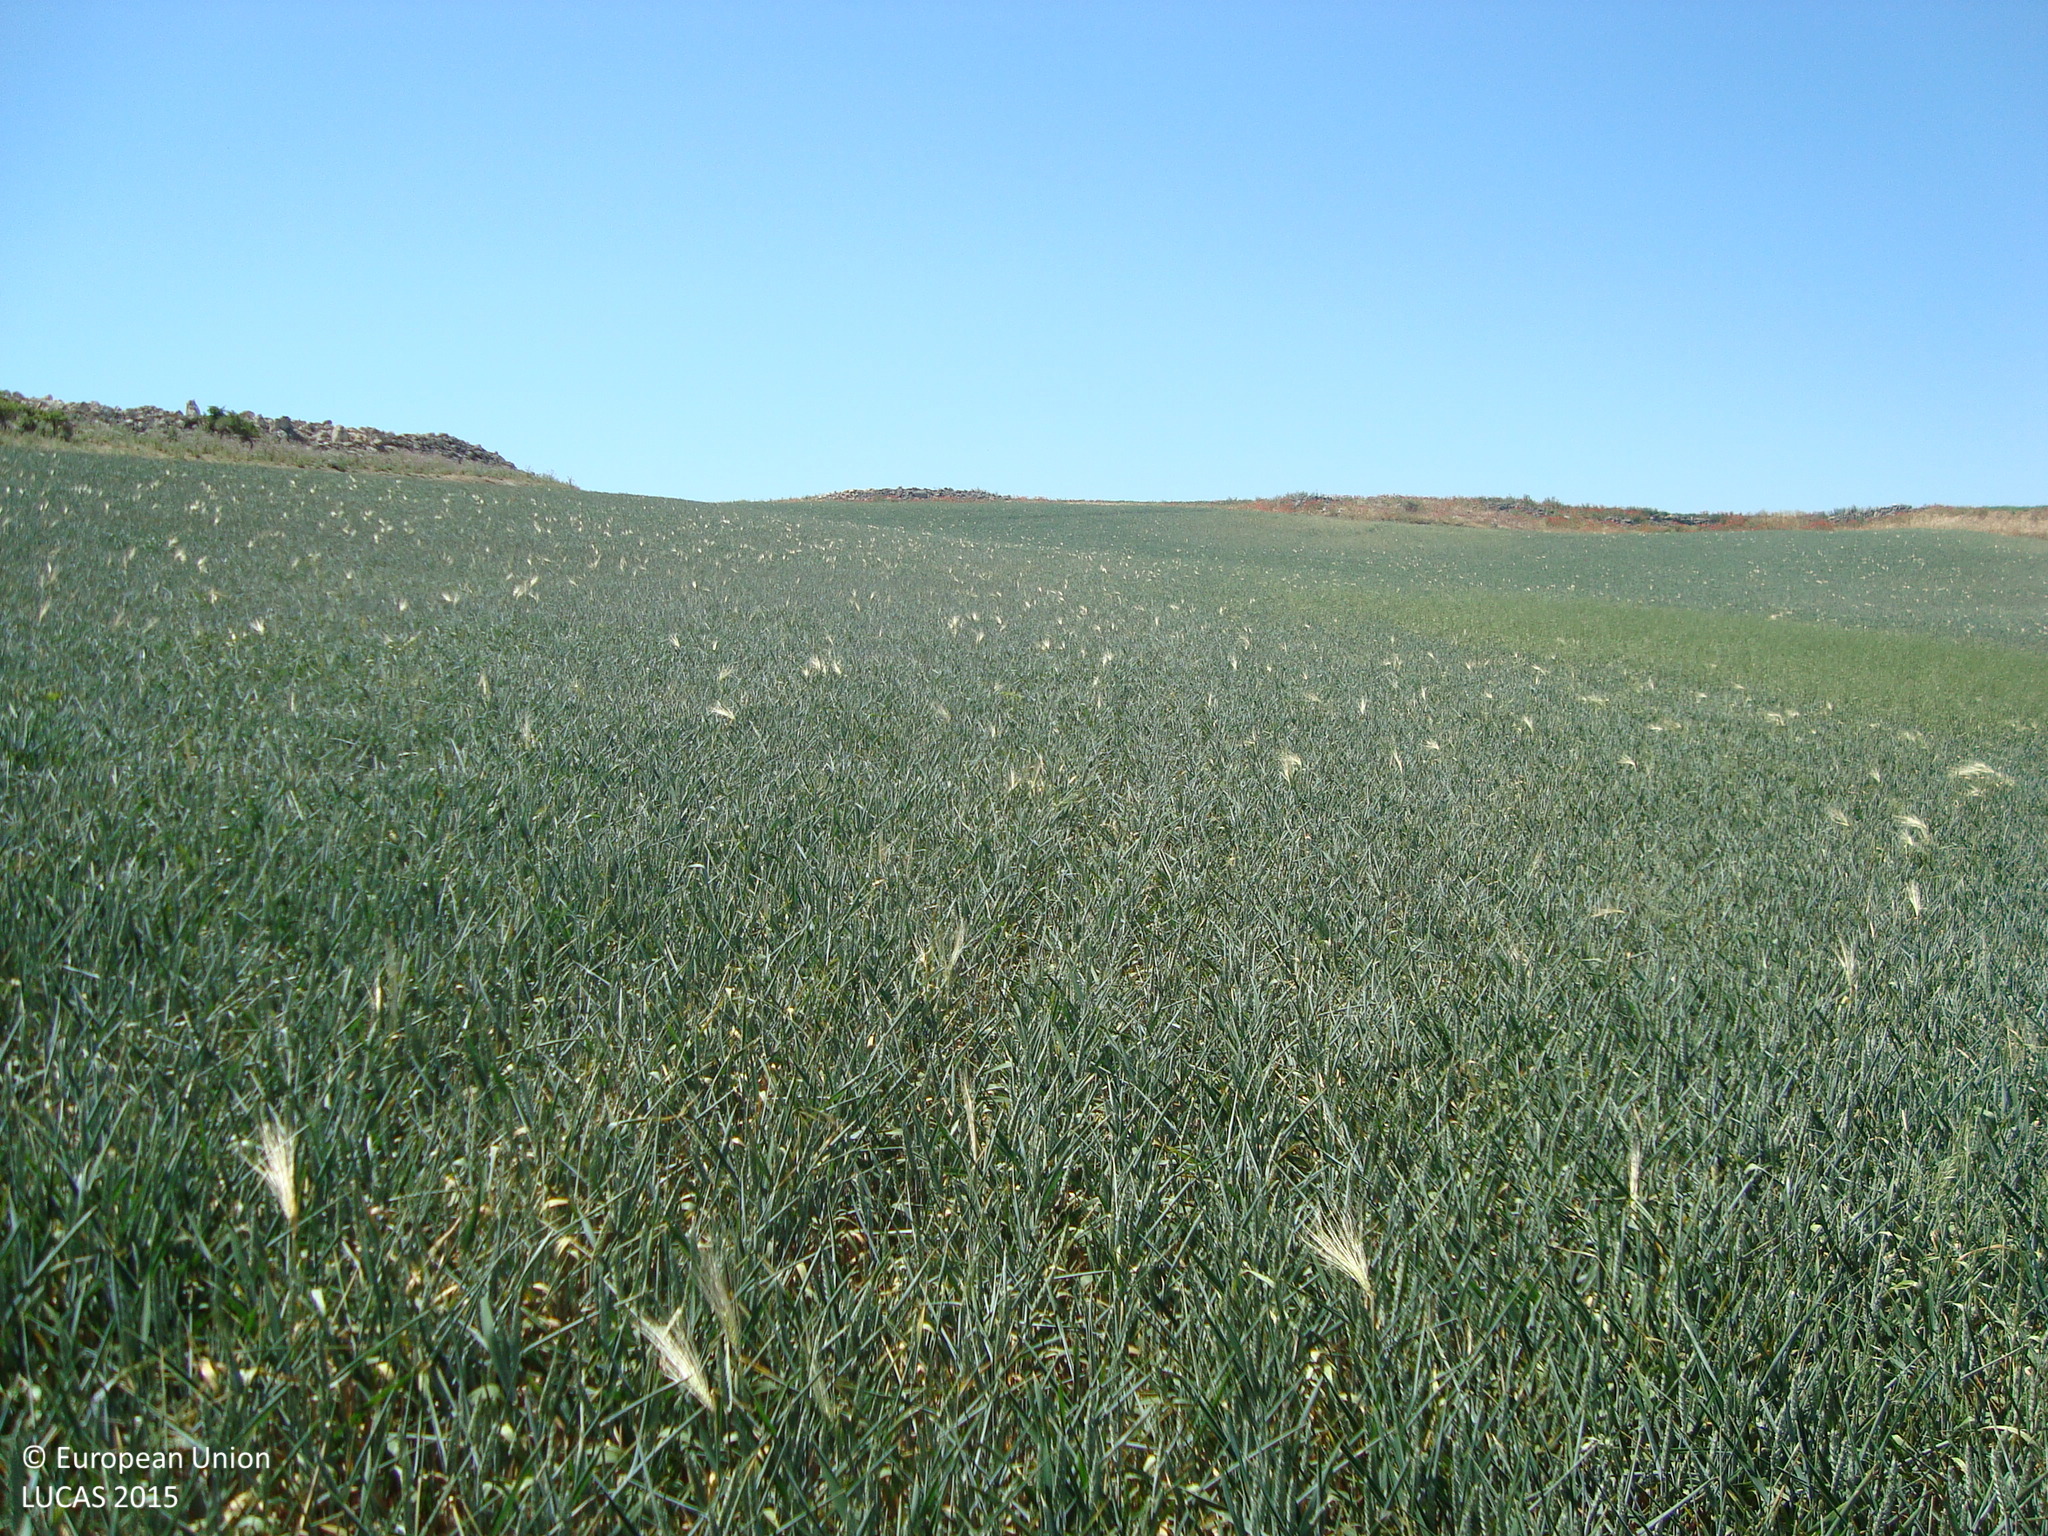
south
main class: Cropland
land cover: Common wheat
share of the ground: > 75 %
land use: Agriculture (excluding fallow land and kitchen gardens)
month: May
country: ES
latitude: 41.5603
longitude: -4.1717
